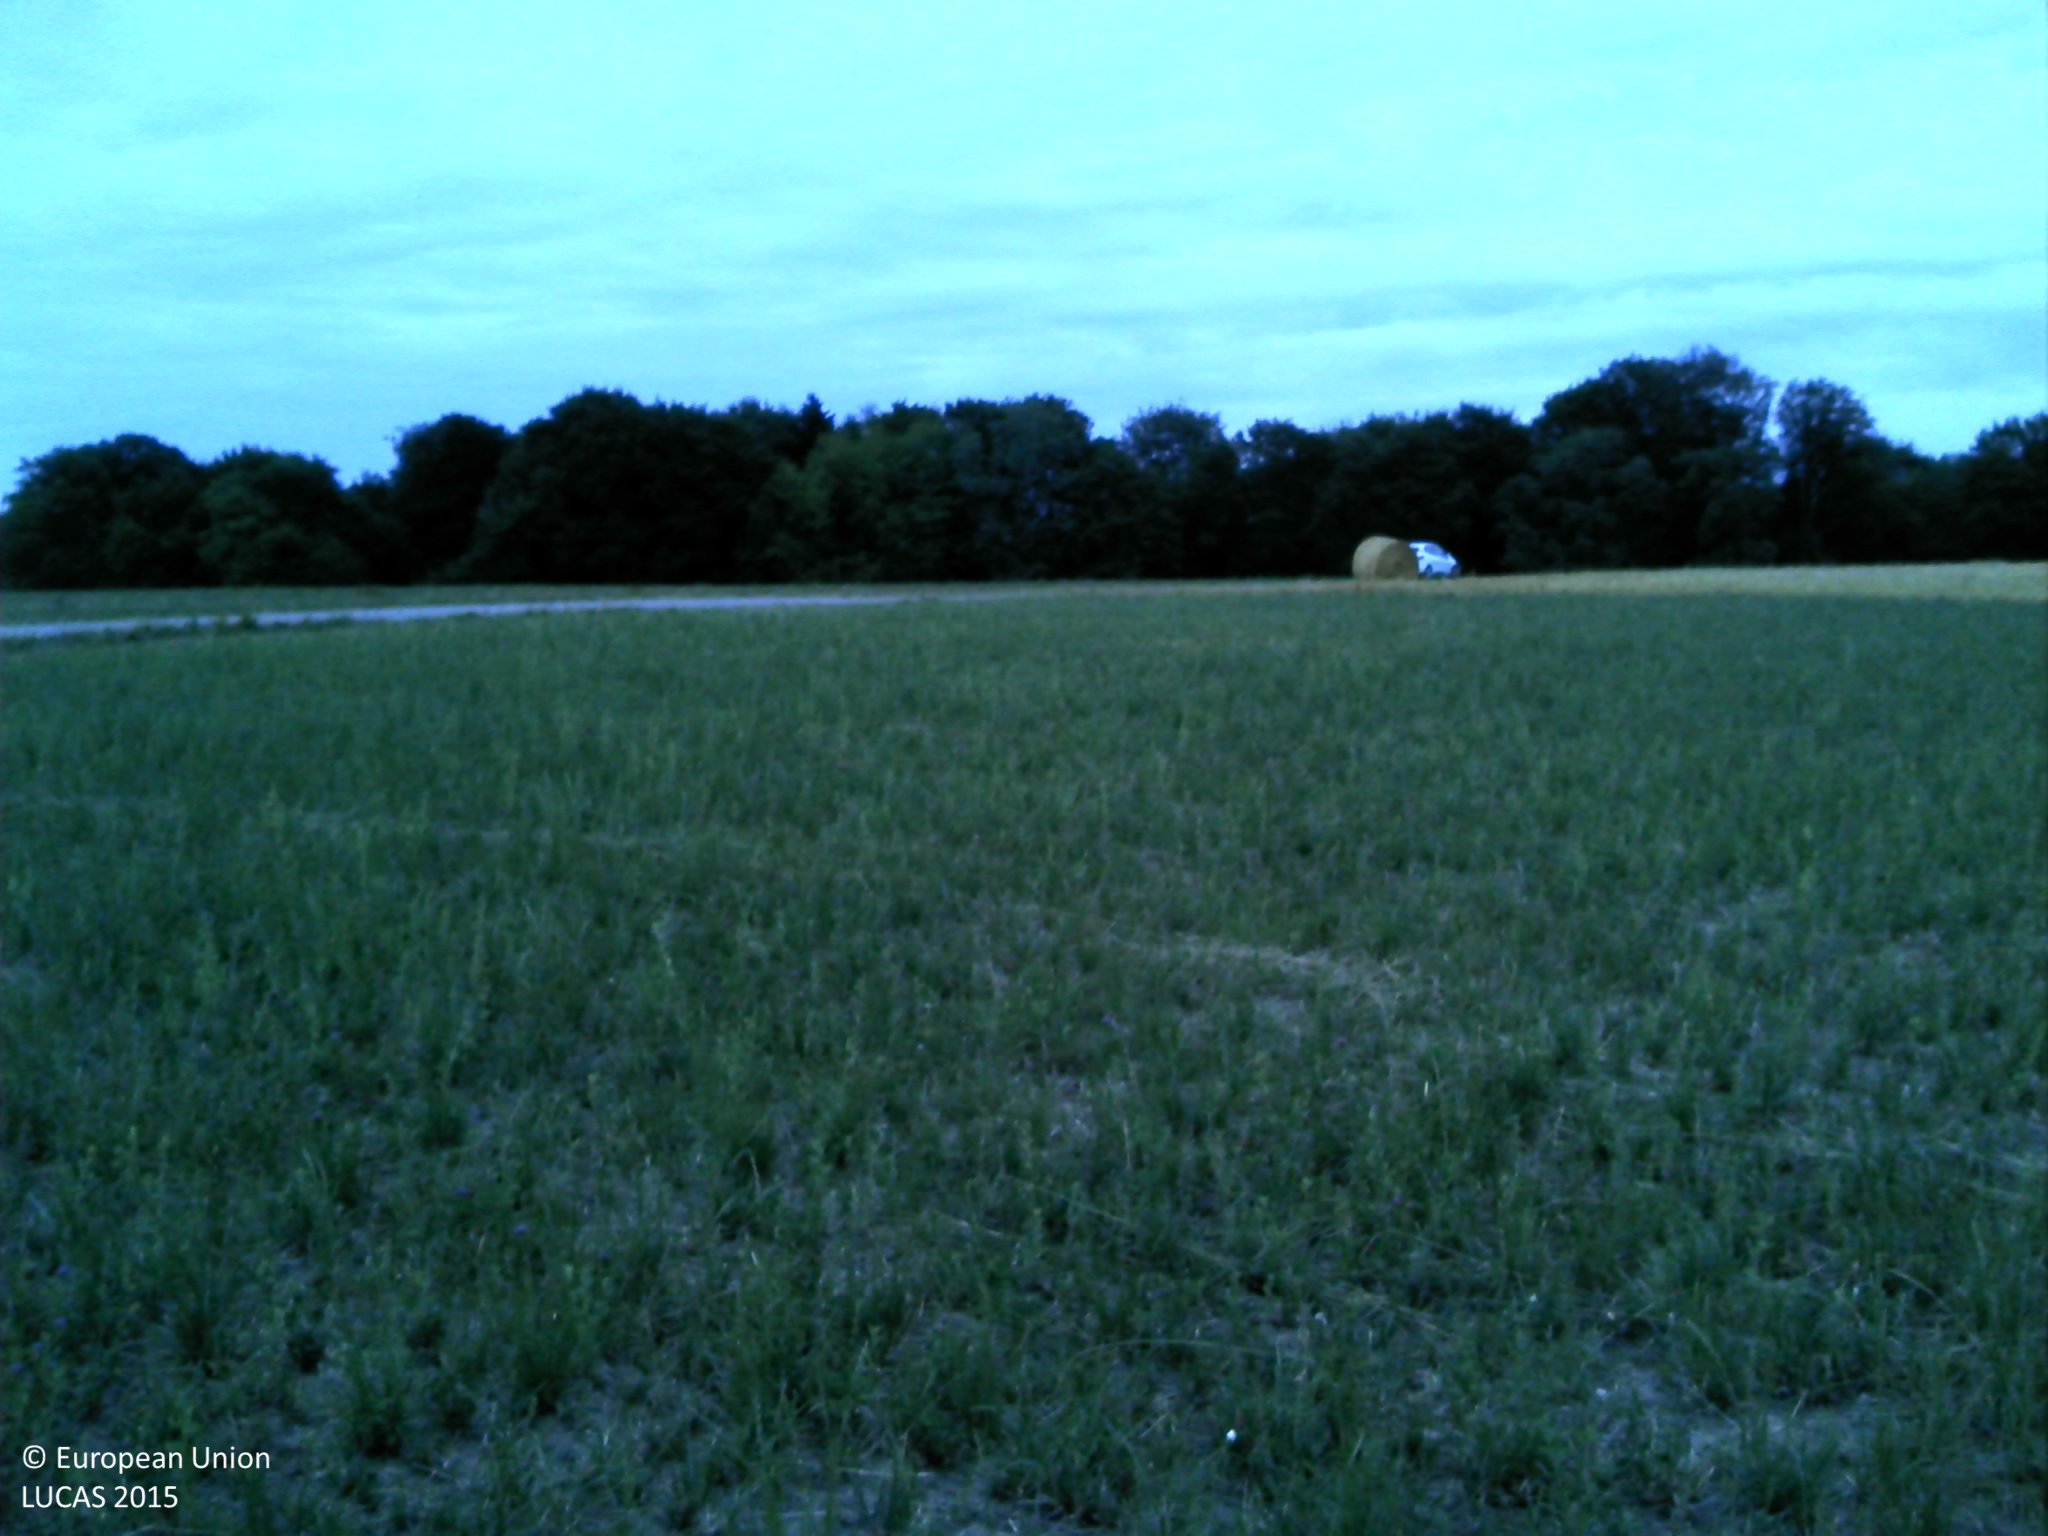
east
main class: Grassland
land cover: Grassland without tree/shrub cover
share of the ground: 50 - 75 %
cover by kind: herbaceous plants 100 %
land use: Agriculture (excluding fallow land and kitchen gardens)
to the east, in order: Grassland without tree/shrub cover; Paved roads, cycling and walking lanes; Grassland without tree/shrub cover; Spruce dominated mixed woodland
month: August
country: FR
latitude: 48.1238
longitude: 6.2524
